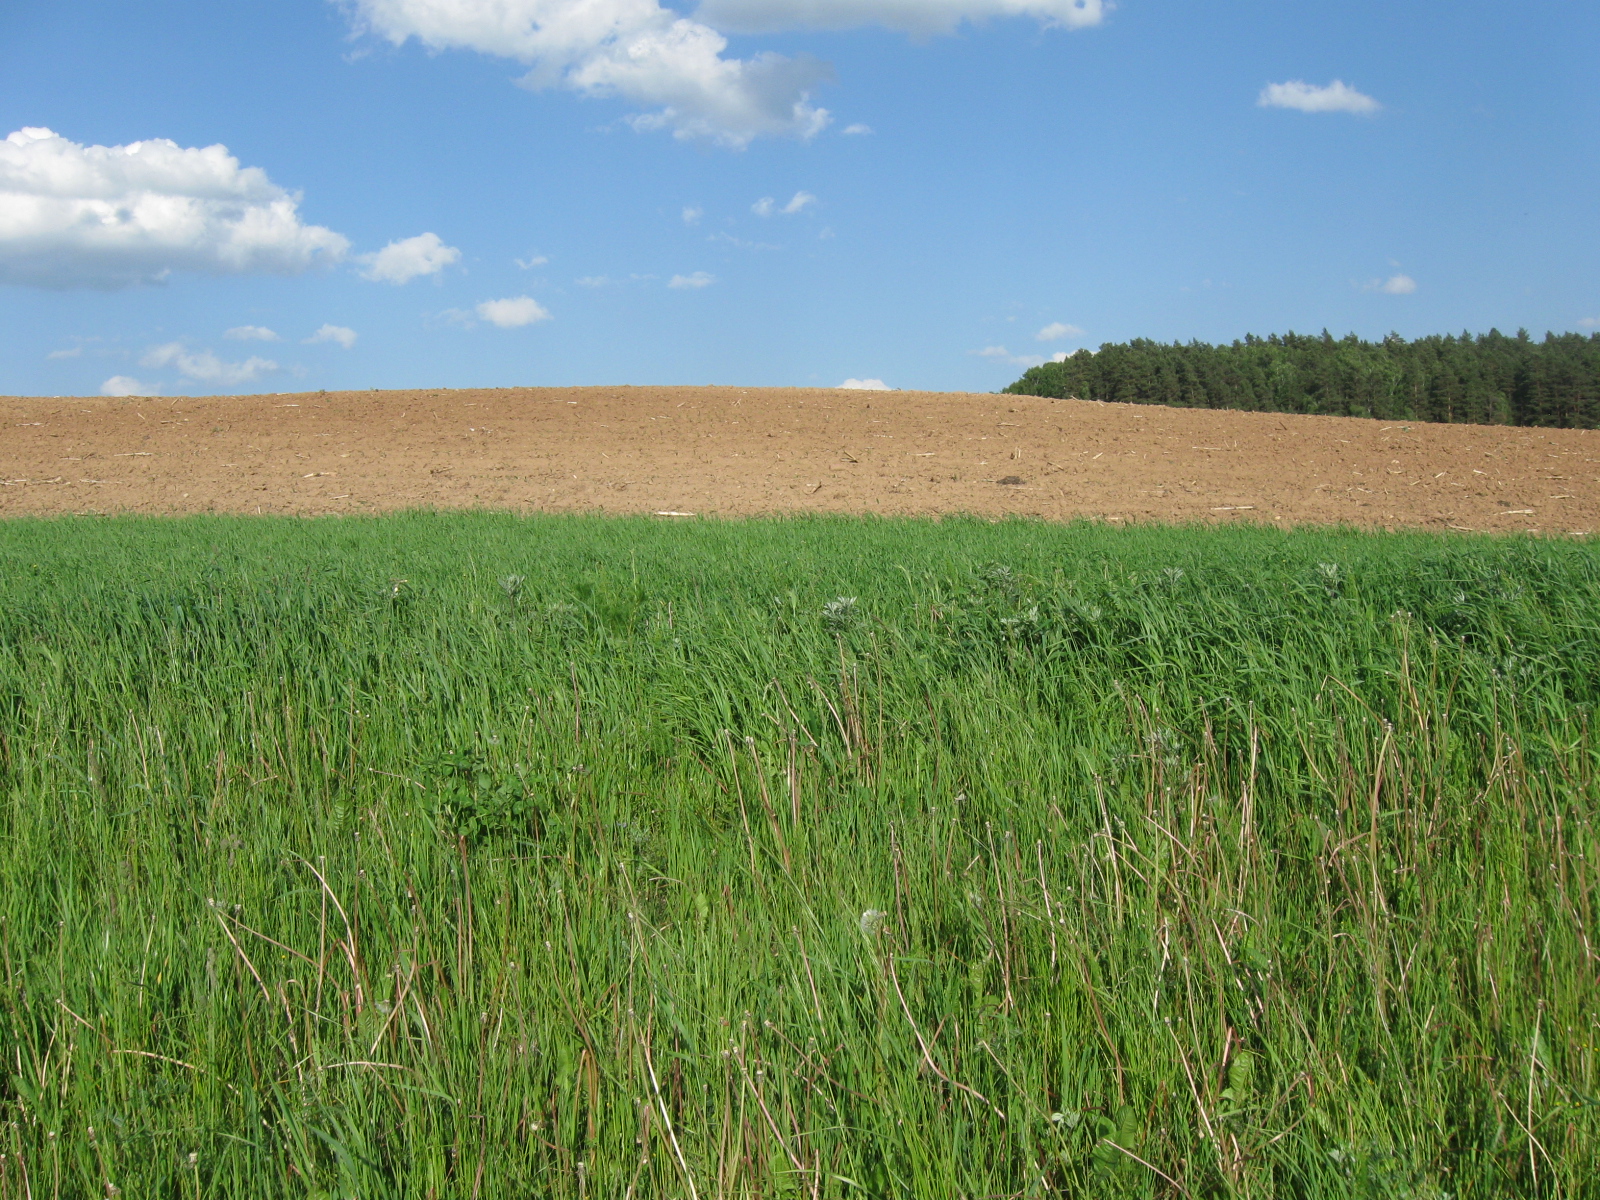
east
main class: Grassland
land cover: Grassland without tree/shrub cover
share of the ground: > 75 %
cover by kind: herbaceous plants 100 %
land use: Agriculture (excluding fallow land and kitchen gardens)
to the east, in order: Grassland without tree/shrub cover; Other leguminous and mixtures for fodder; Maize; Grassland without tree/shrub cover
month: June
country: LT
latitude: 54.2398
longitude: 23.7278
